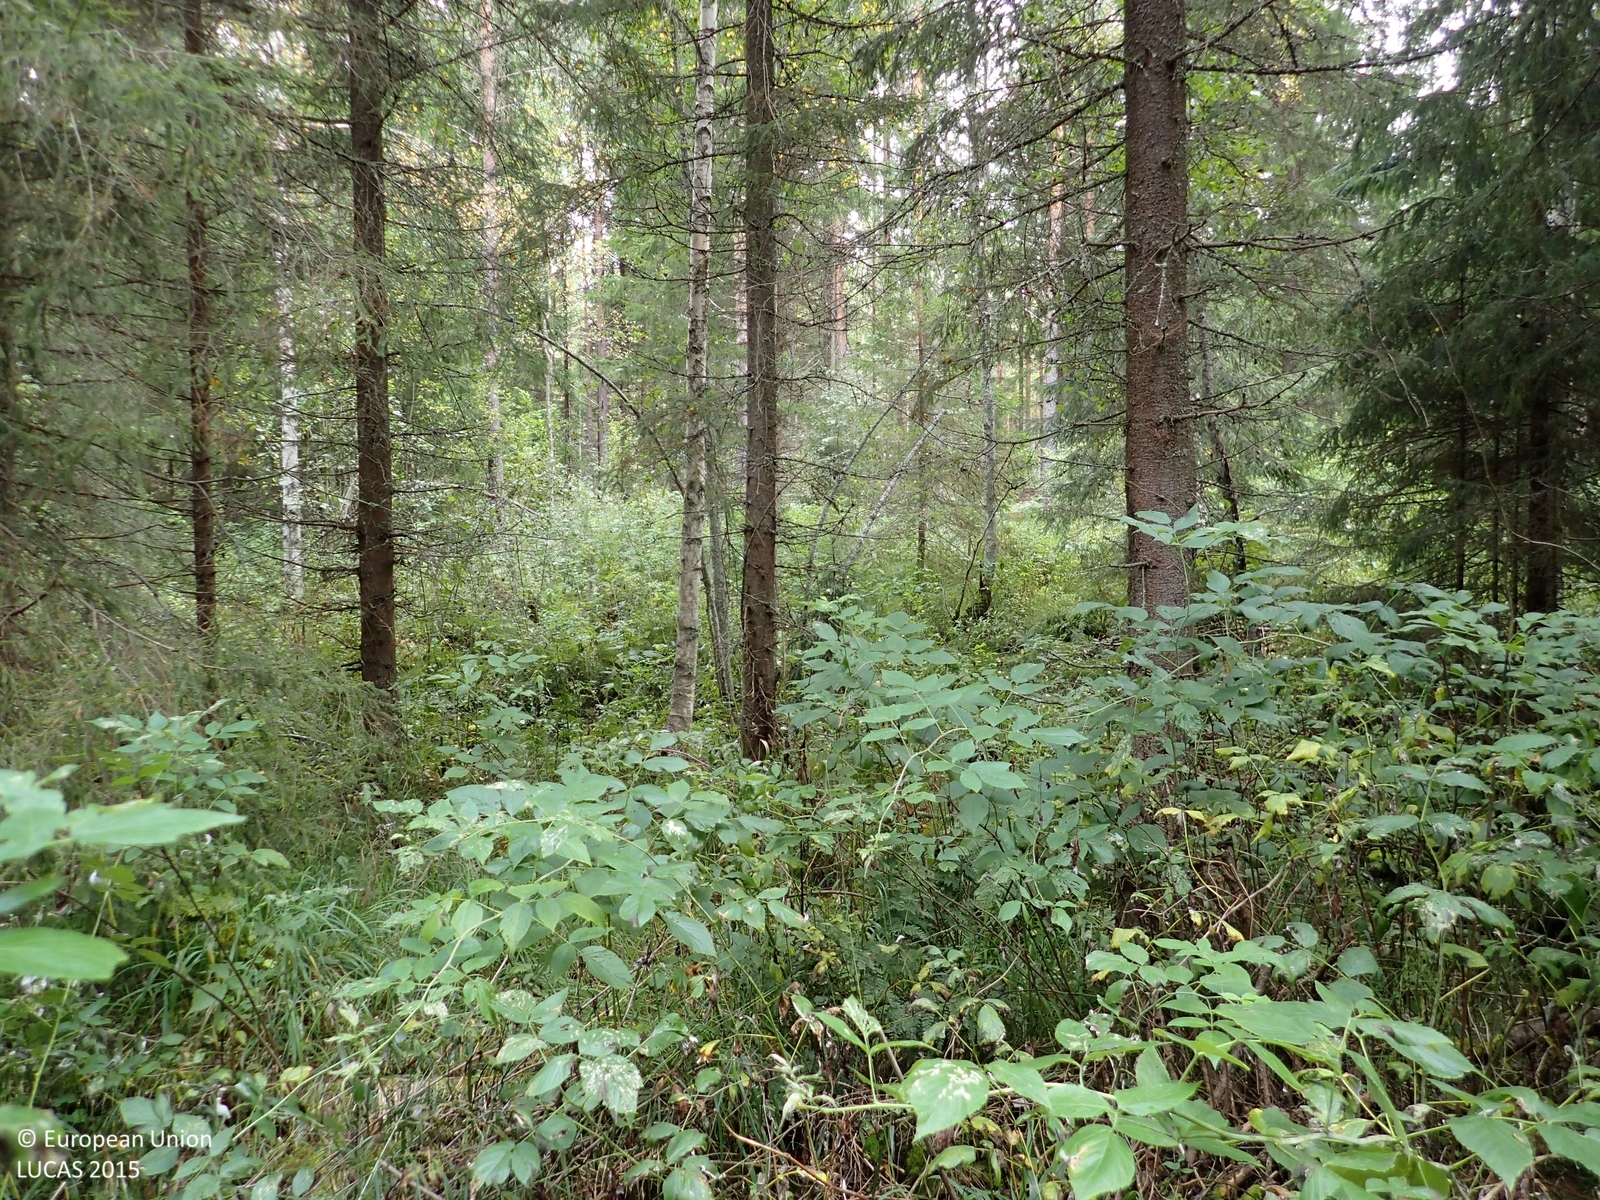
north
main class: Woodland
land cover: Spruce dominated mixed woodland
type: boreal forest
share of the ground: > 75 %
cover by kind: coniferous forest trees 55 %, broadleaved forest trees 20 %, herbaceous plants 20 %, lichens and mosses 5 %
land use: Forestry
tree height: > 5 m
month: September
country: FI
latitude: 62.9630
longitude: 25.8714
